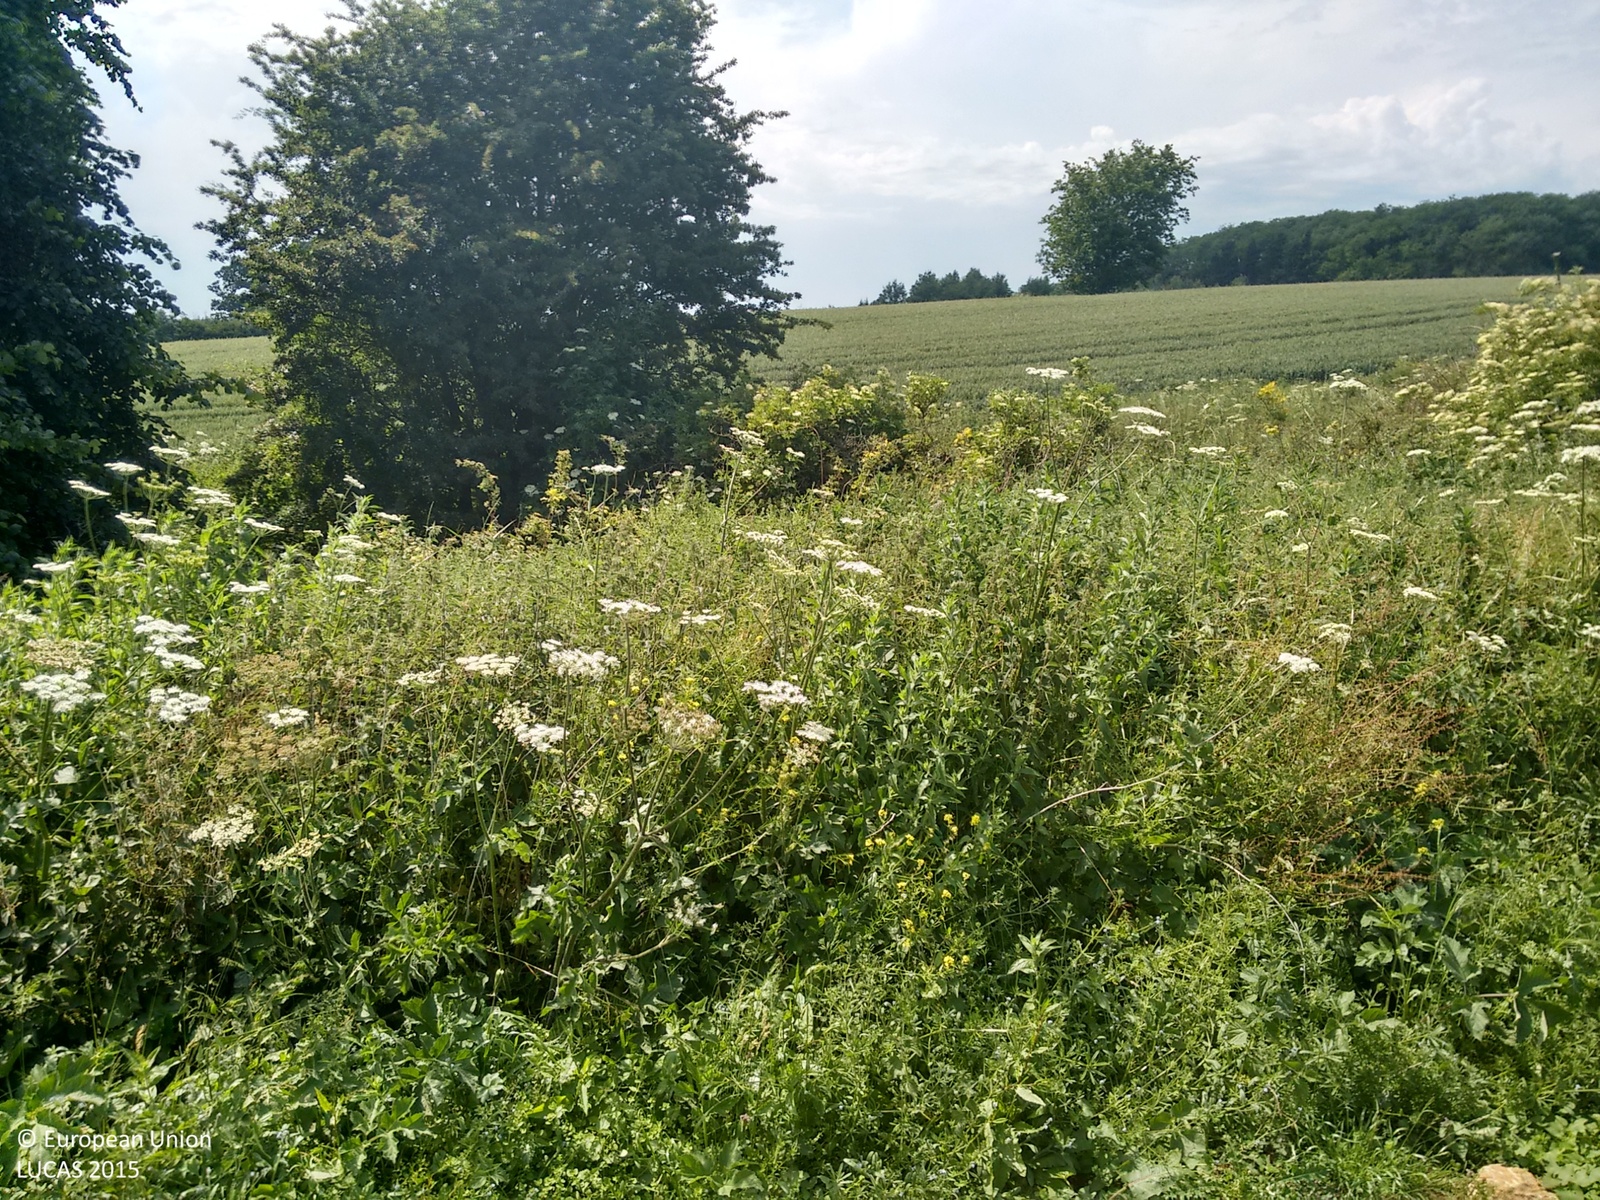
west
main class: Cropland
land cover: Common wheat
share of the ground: > 75 %
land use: Agriculture (excluding fallow land and kitchen gardens)
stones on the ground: < 10 %
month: July
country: GB
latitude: 53.9381
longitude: -0.7484
